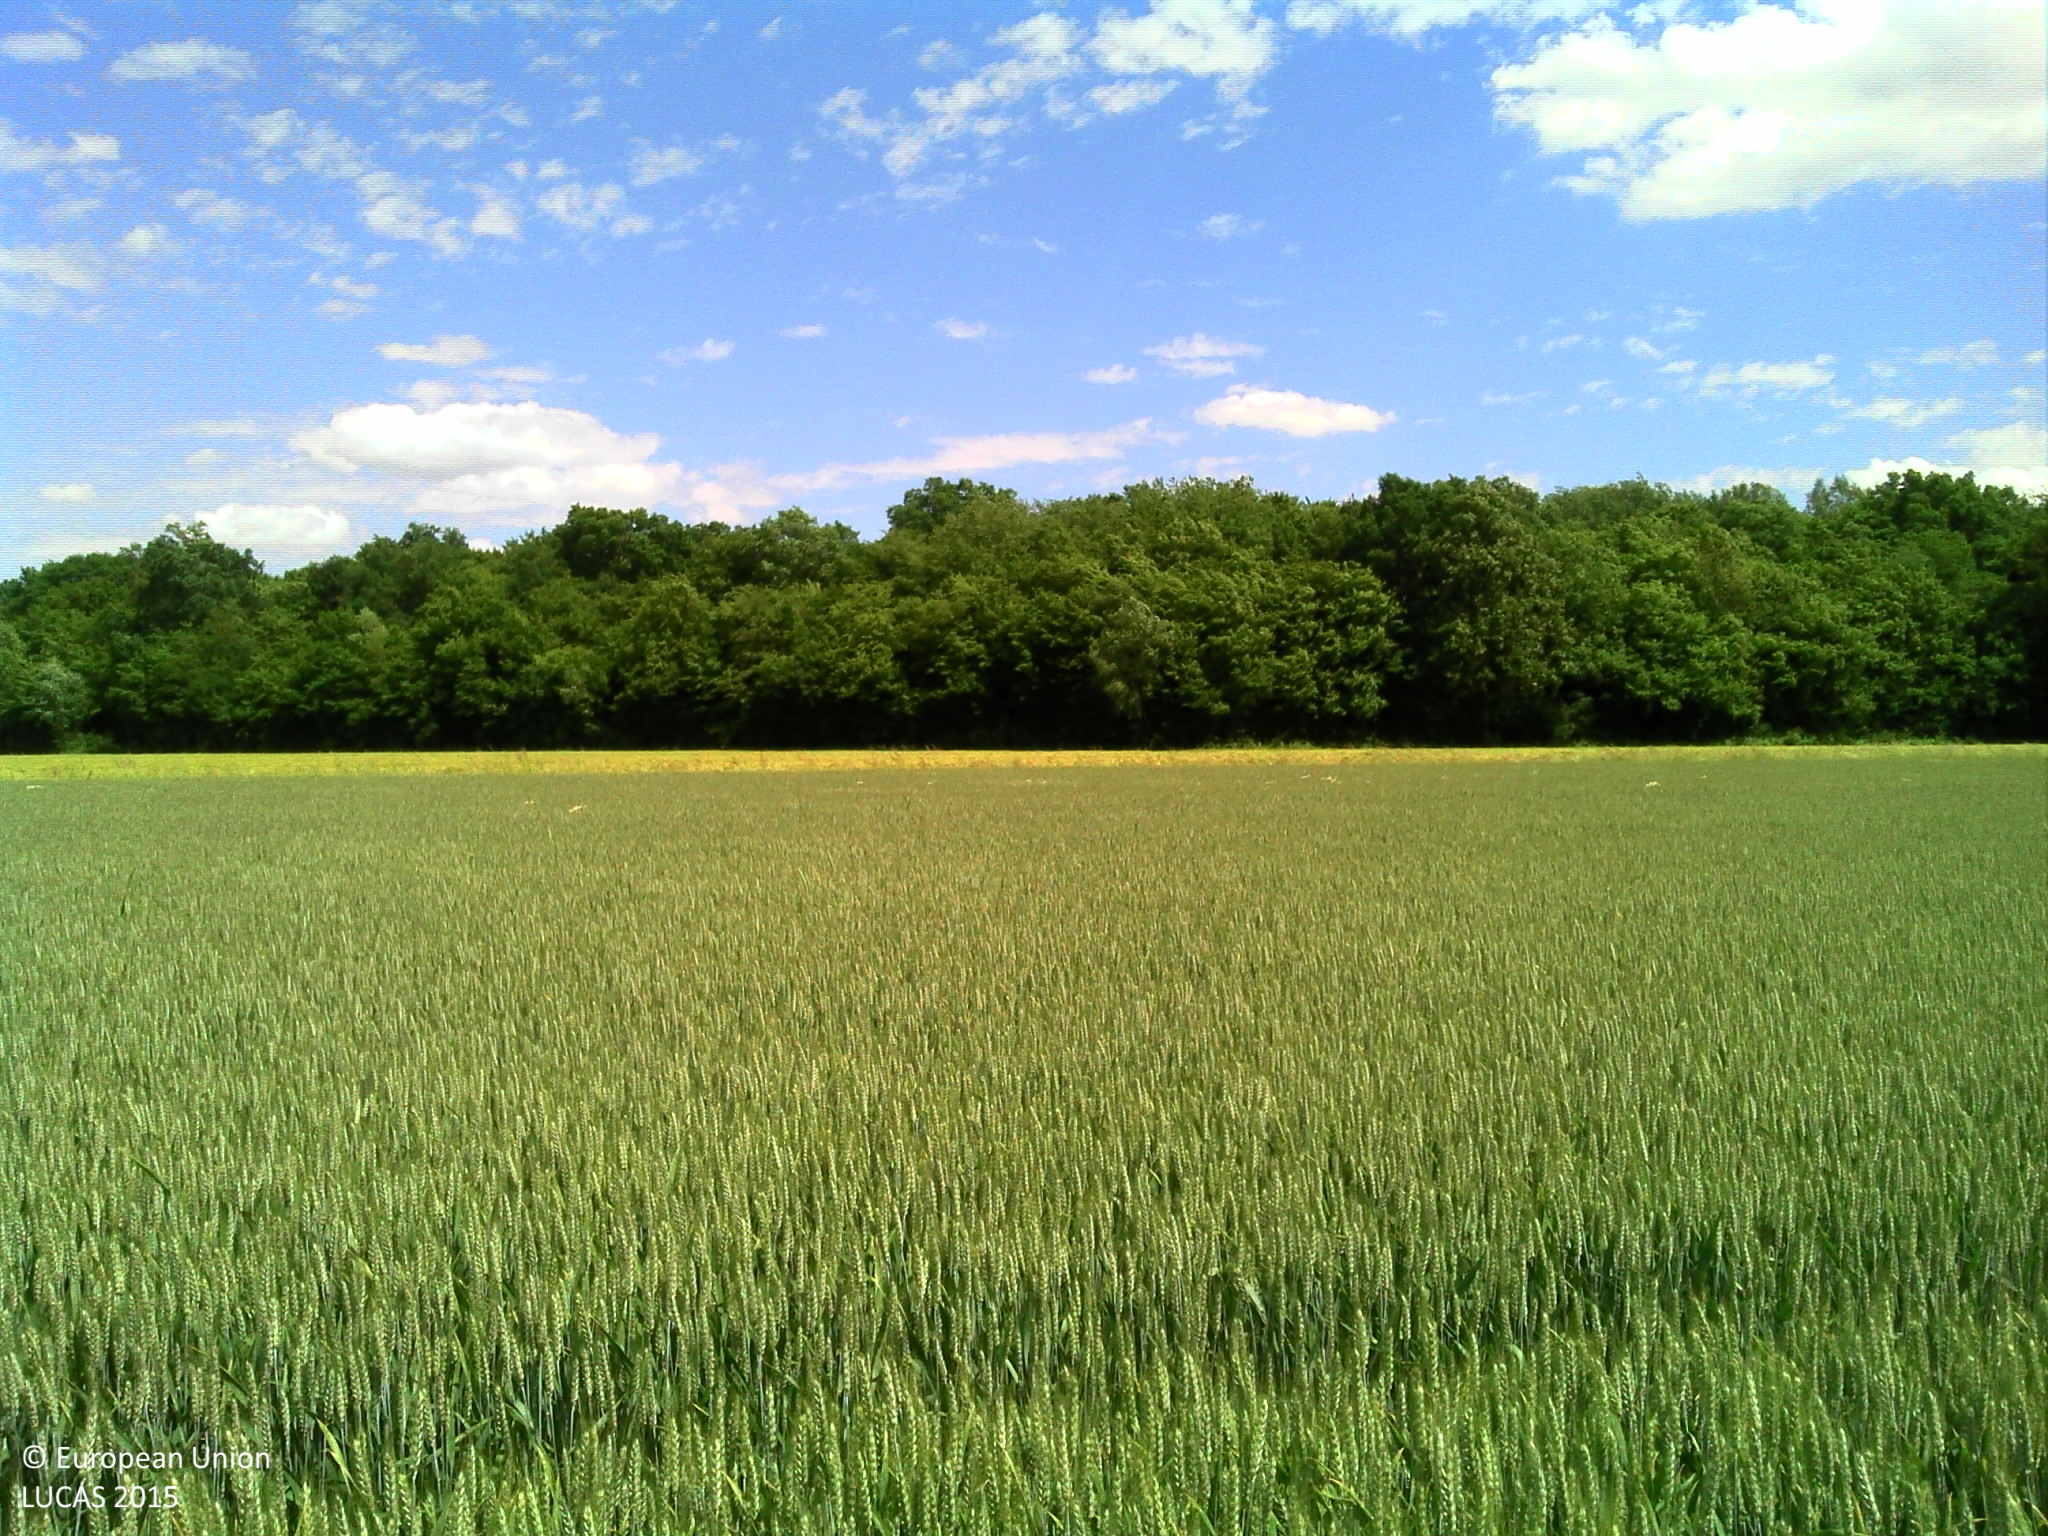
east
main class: Cropland
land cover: Common wheat
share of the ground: > 75 %
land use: Agriculture (excluding fallow land and kitchen gardens)
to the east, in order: Common wheat; Grass margins; Ditches and canals; Grass margins; Barley; Grass margins; Ditches and canals; Broadleaved woodland; Ditches and canals; Broadleaved woodland
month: May
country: FR
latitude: 47.2561
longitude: 5.2570
